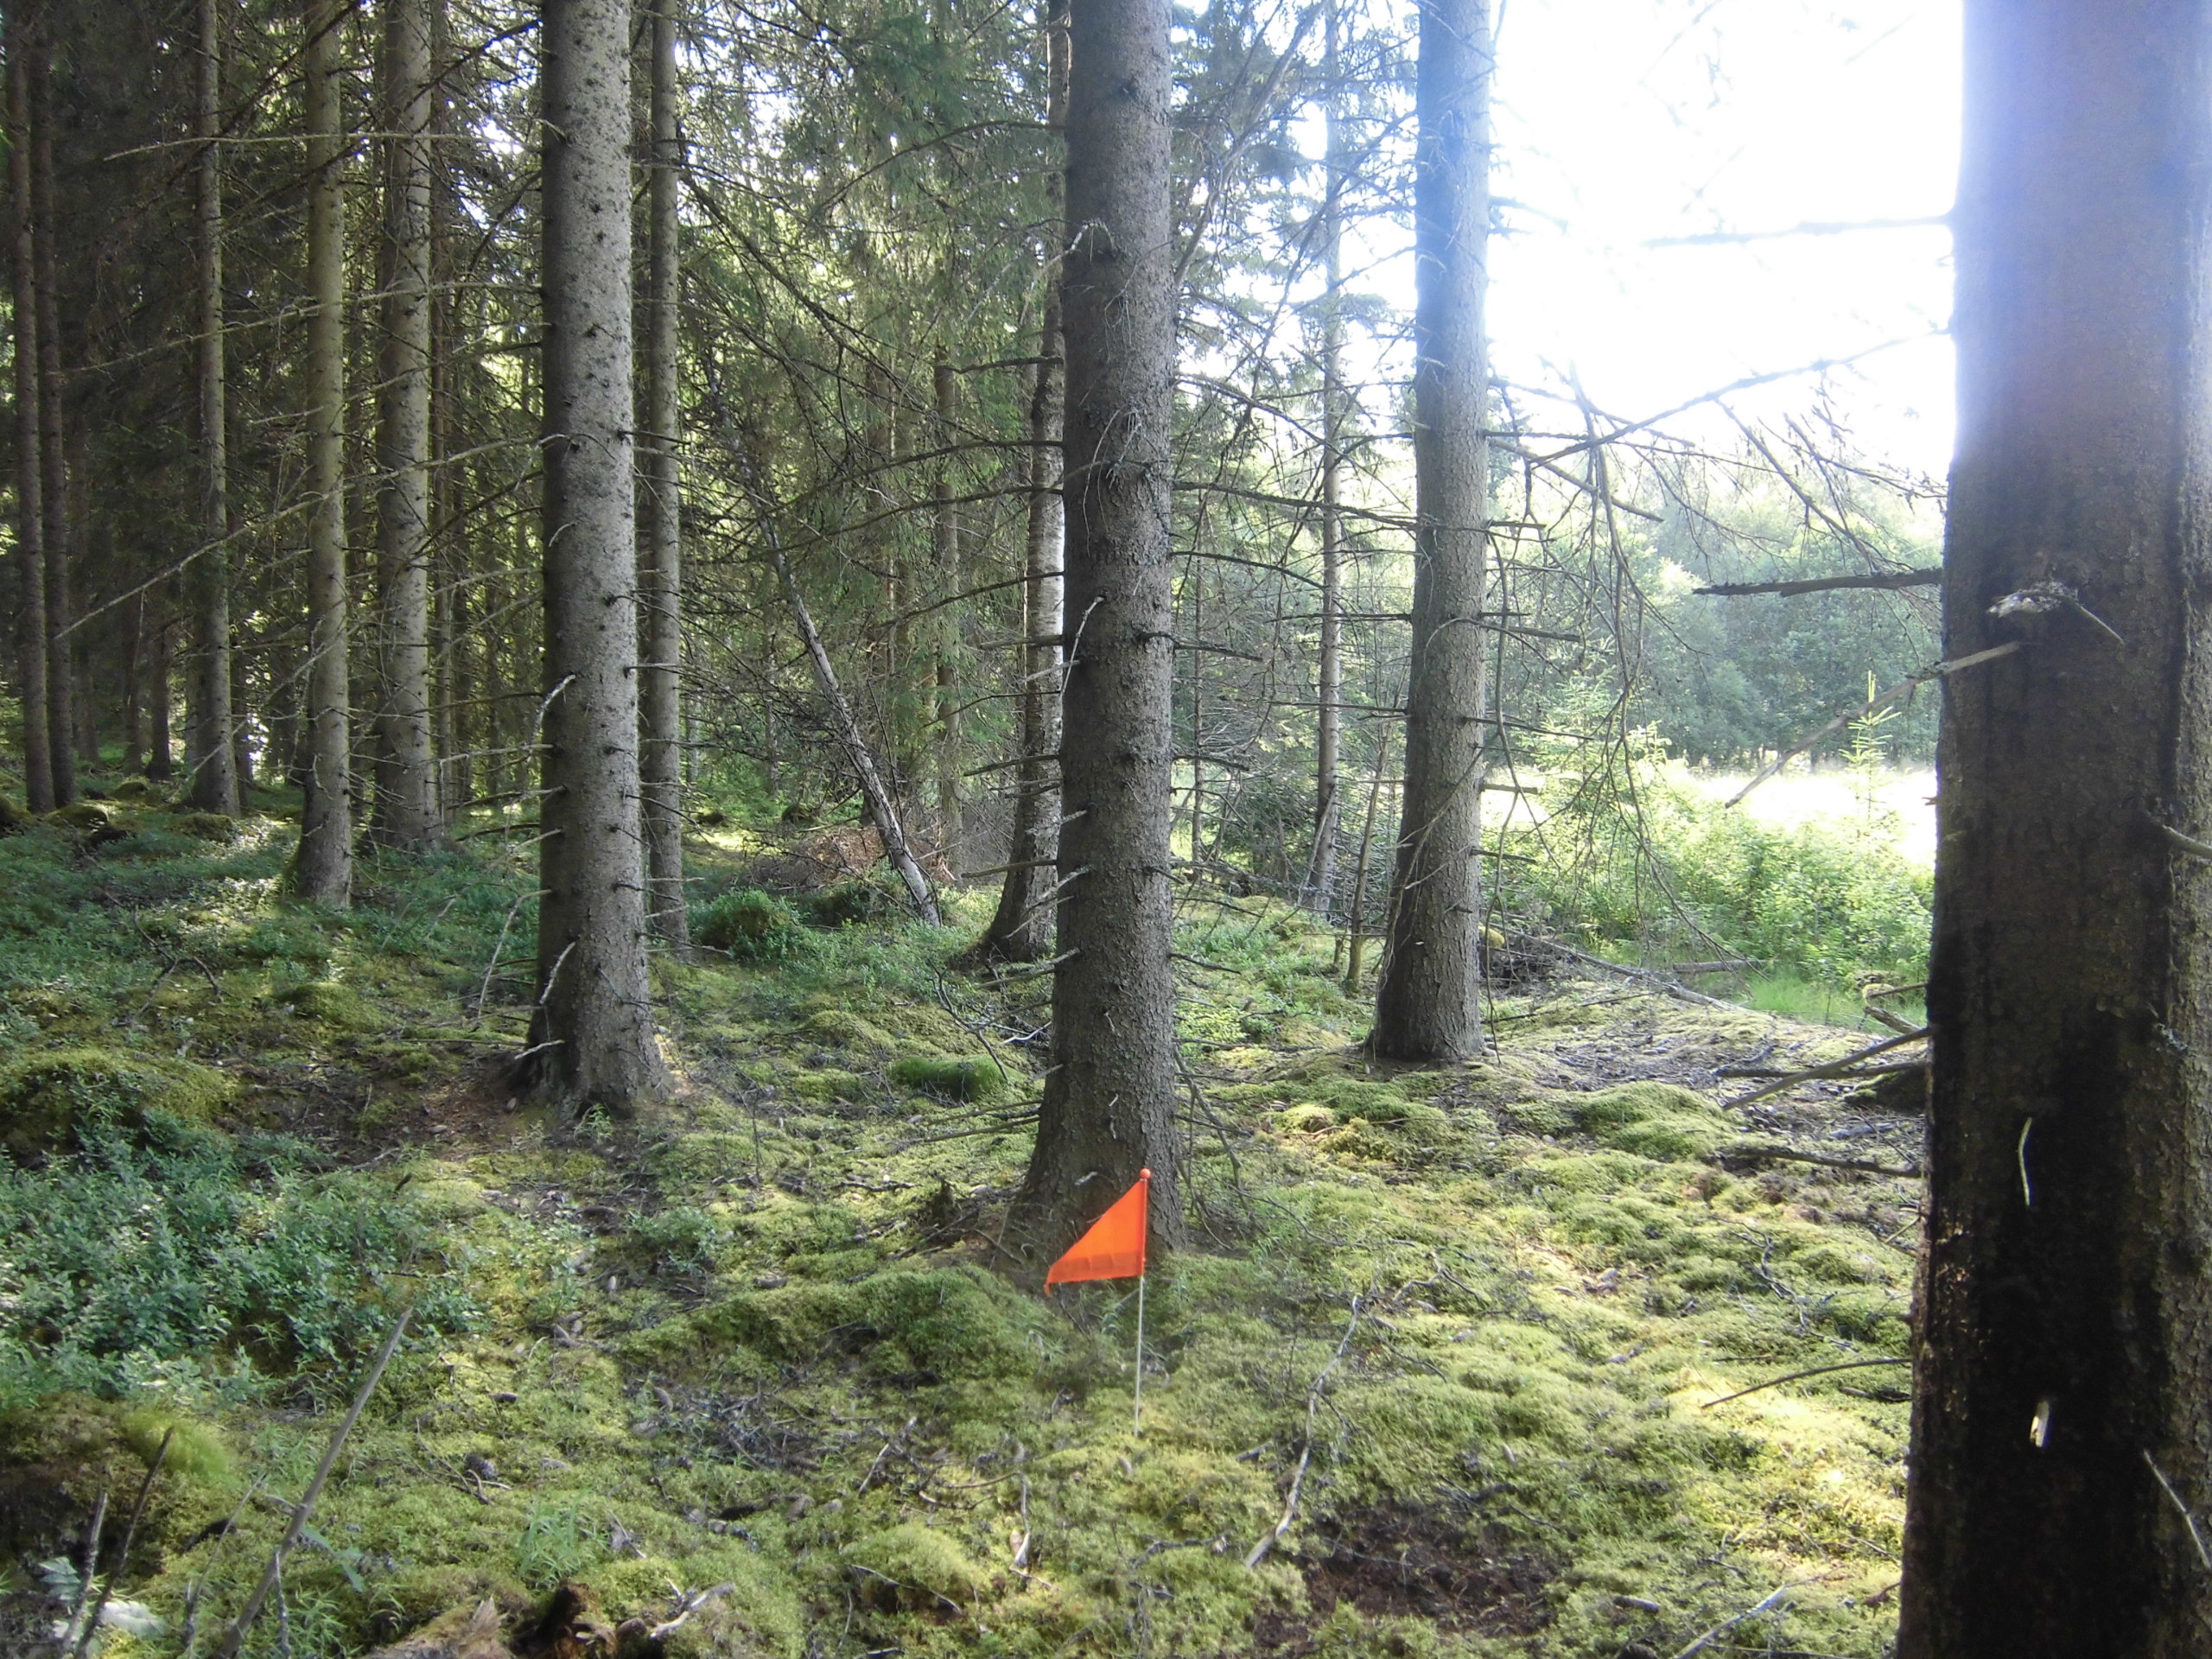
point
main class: Woodland
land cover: Spruce dominated coniferous woodland
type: boreal forest
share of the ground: 50 - 75 %
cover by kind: coniferous forest trees 60 %, shrubs 20 %, herbaceous plants 10 %, lichens and mosses 10 %
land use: Forestry
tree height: > 5 m
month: July
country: SE
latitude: 57.1774
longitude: 15.3070
